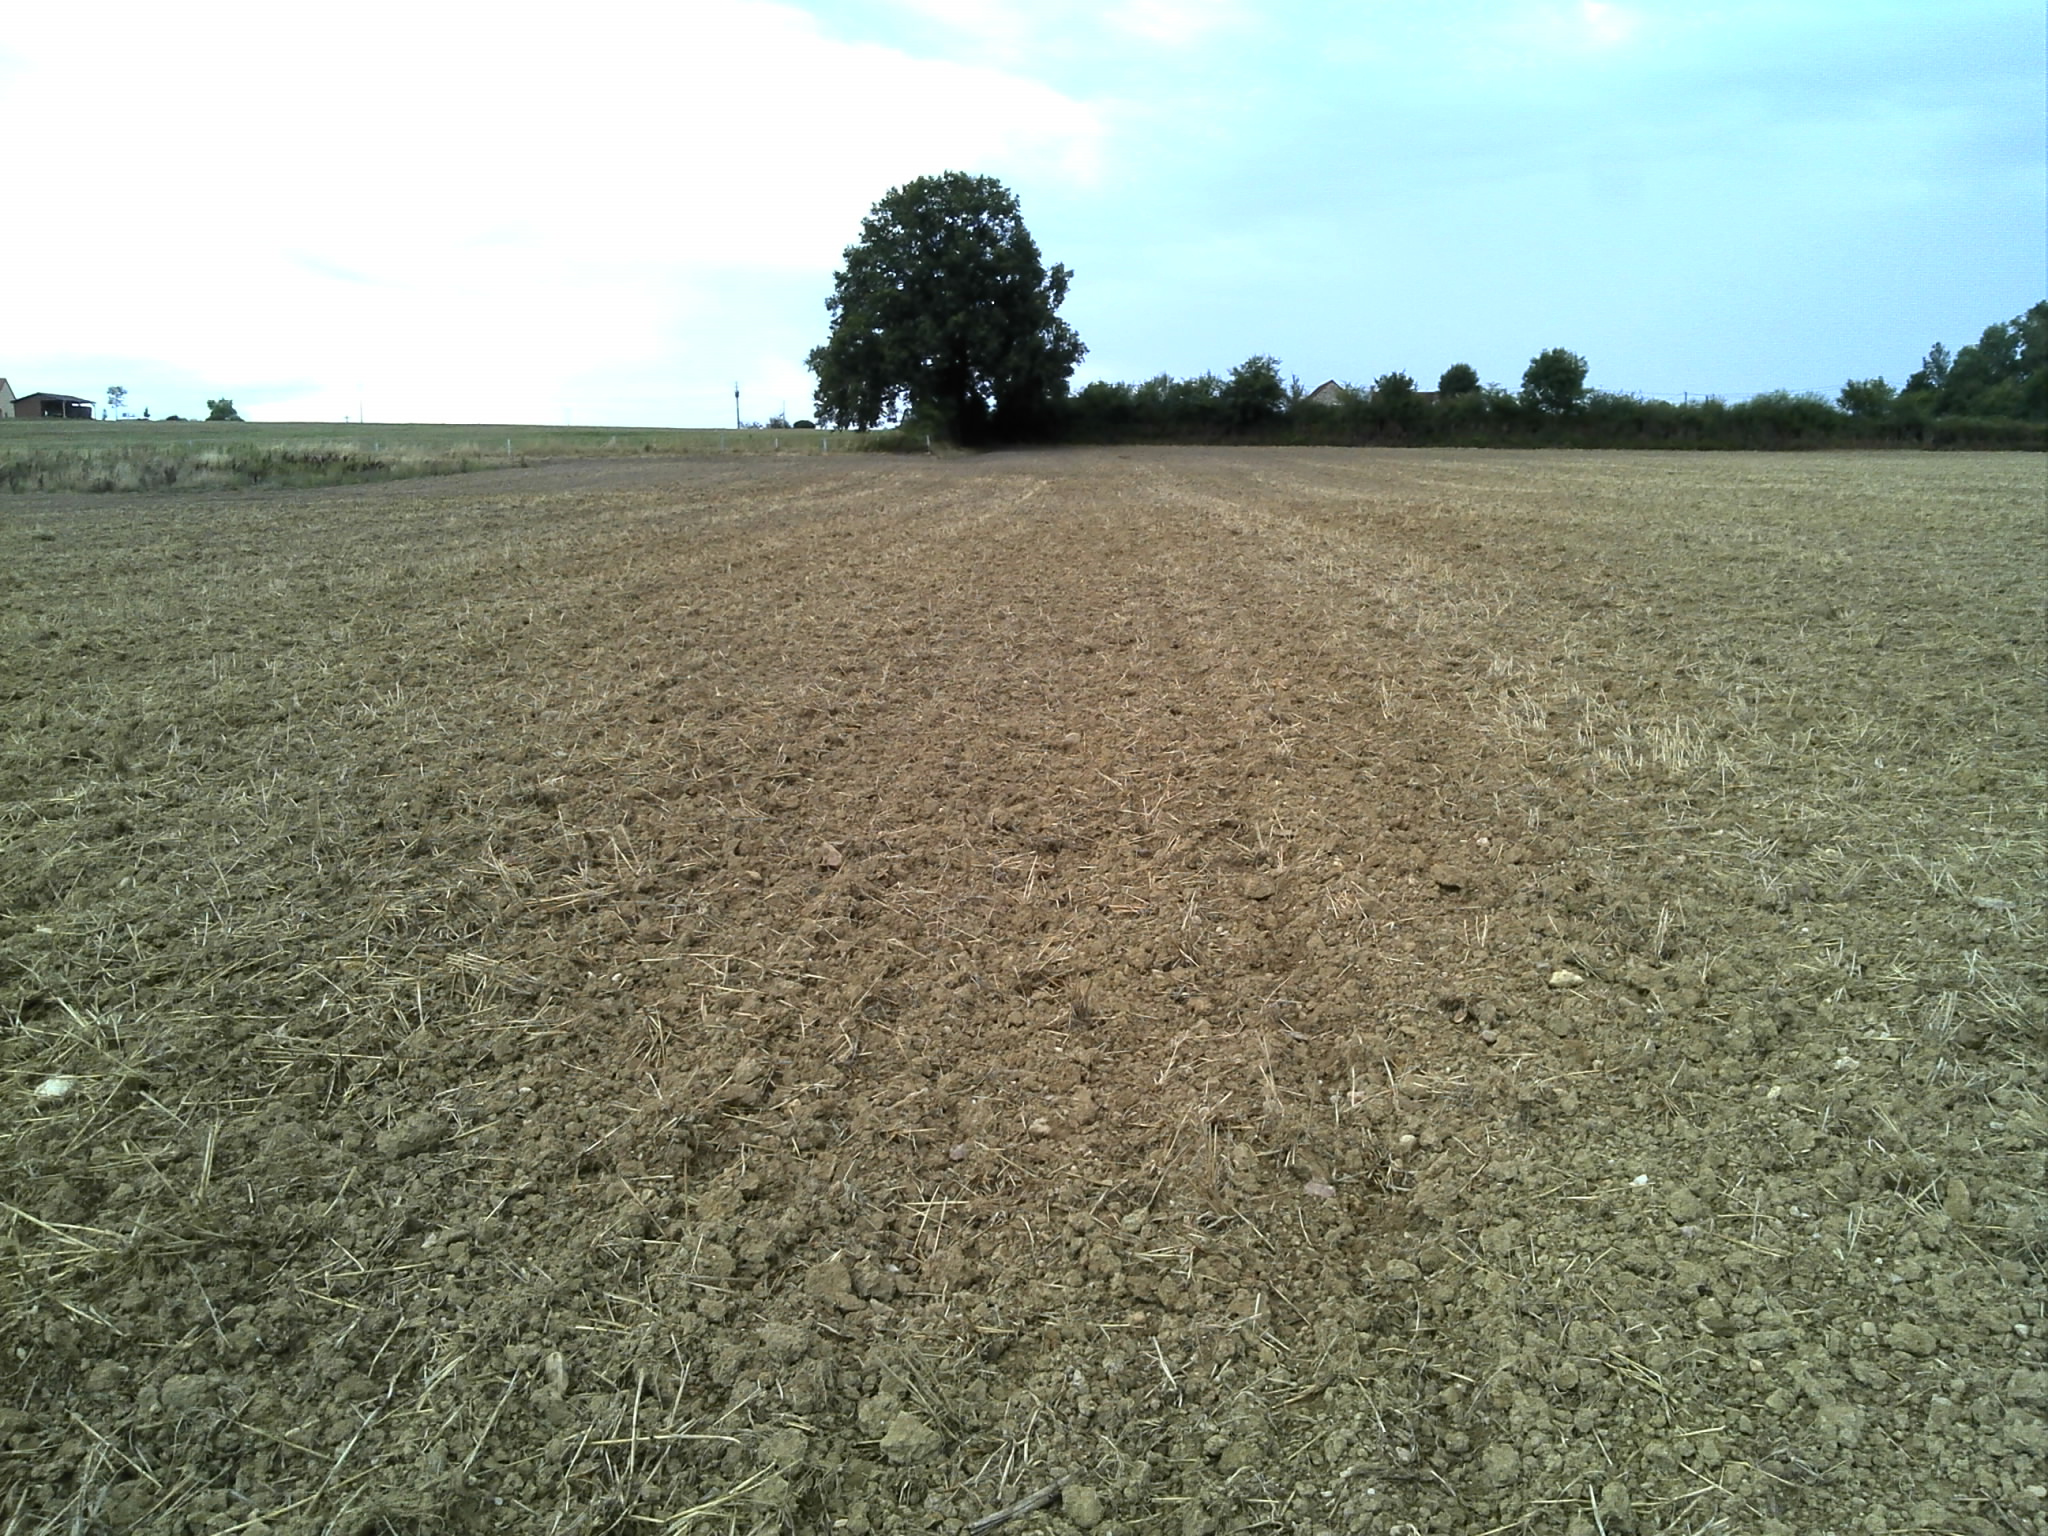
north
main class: Cropland
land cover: Common wheat
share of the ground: > 75 %
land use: Agriculture (excluding fallow land and kitchen gardens)
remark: Tilled/Sowed
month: August
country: FR
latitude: 46.6247
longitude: 2.1700
